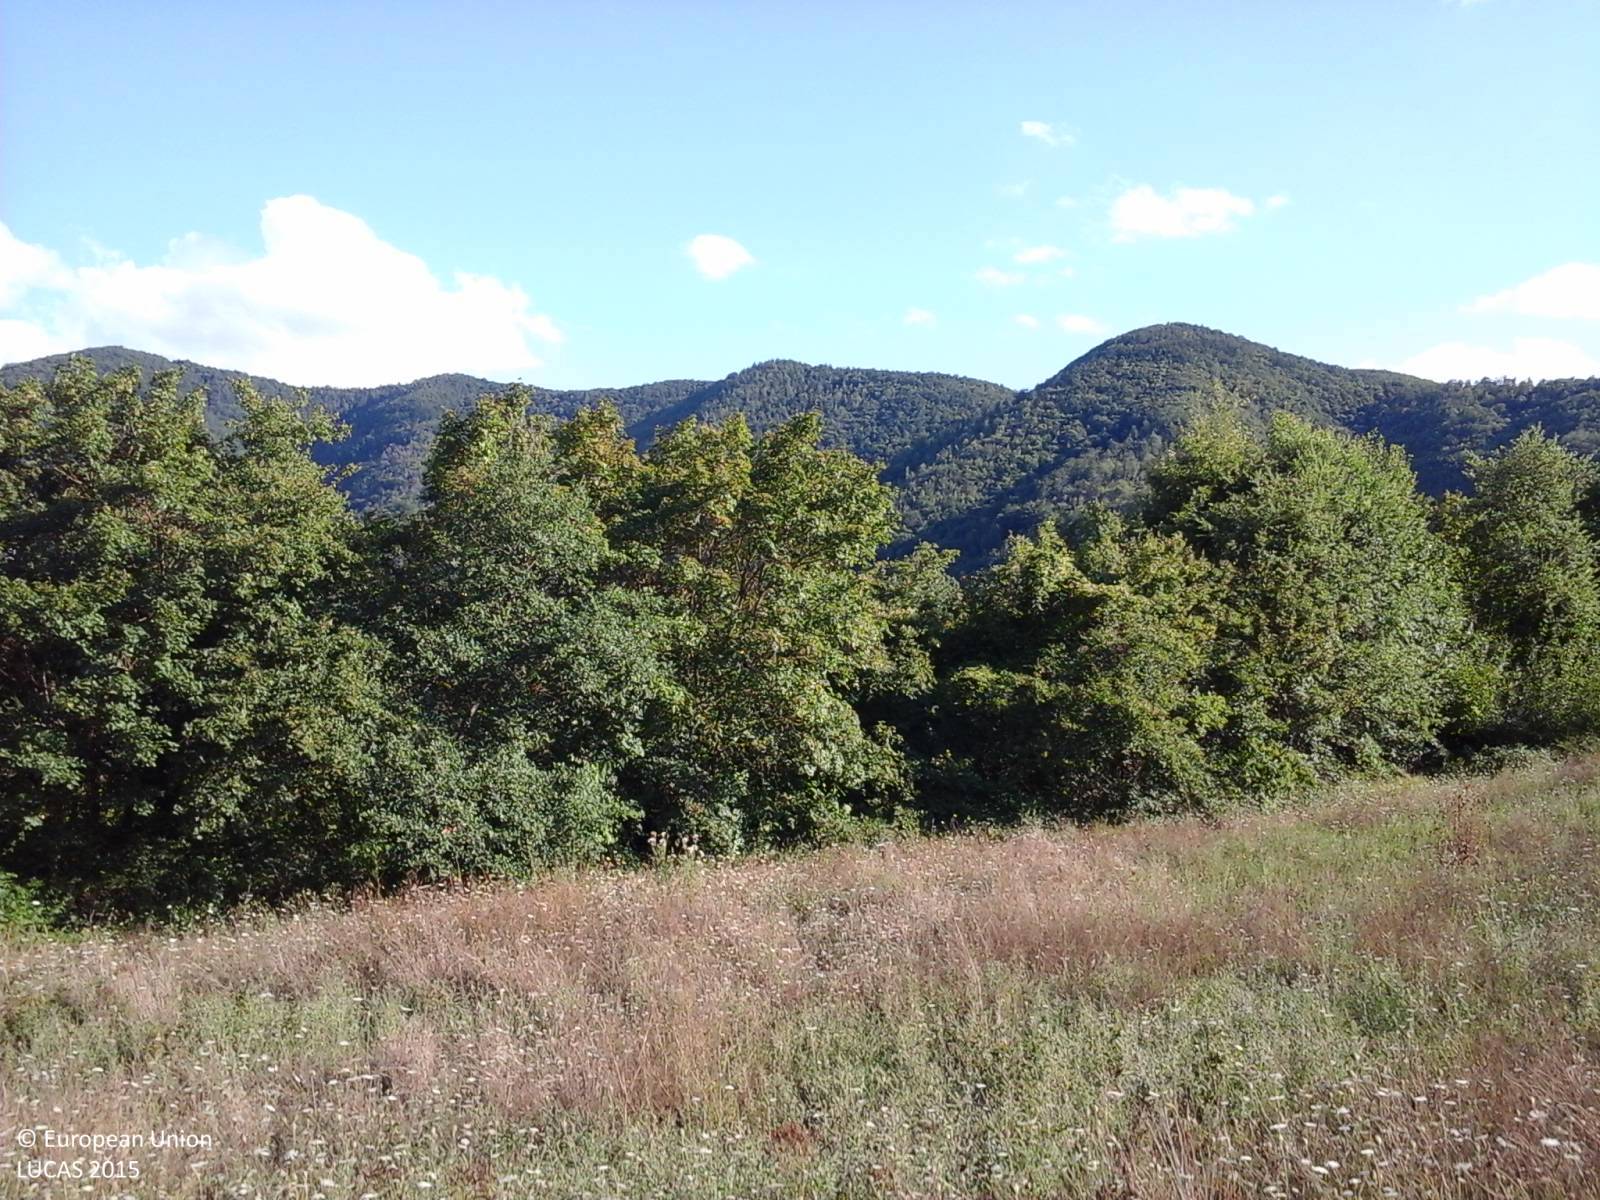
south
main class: Grassland
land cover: Grassland without tree/shrub cover
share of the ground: > 75 %
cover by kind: herbaceous plants 100 %
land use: Agriculture (excluding fallow land and kitchen gardens)
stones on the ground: < 10 %
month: August
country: IT
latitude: 43.3005
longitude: 12.1020
